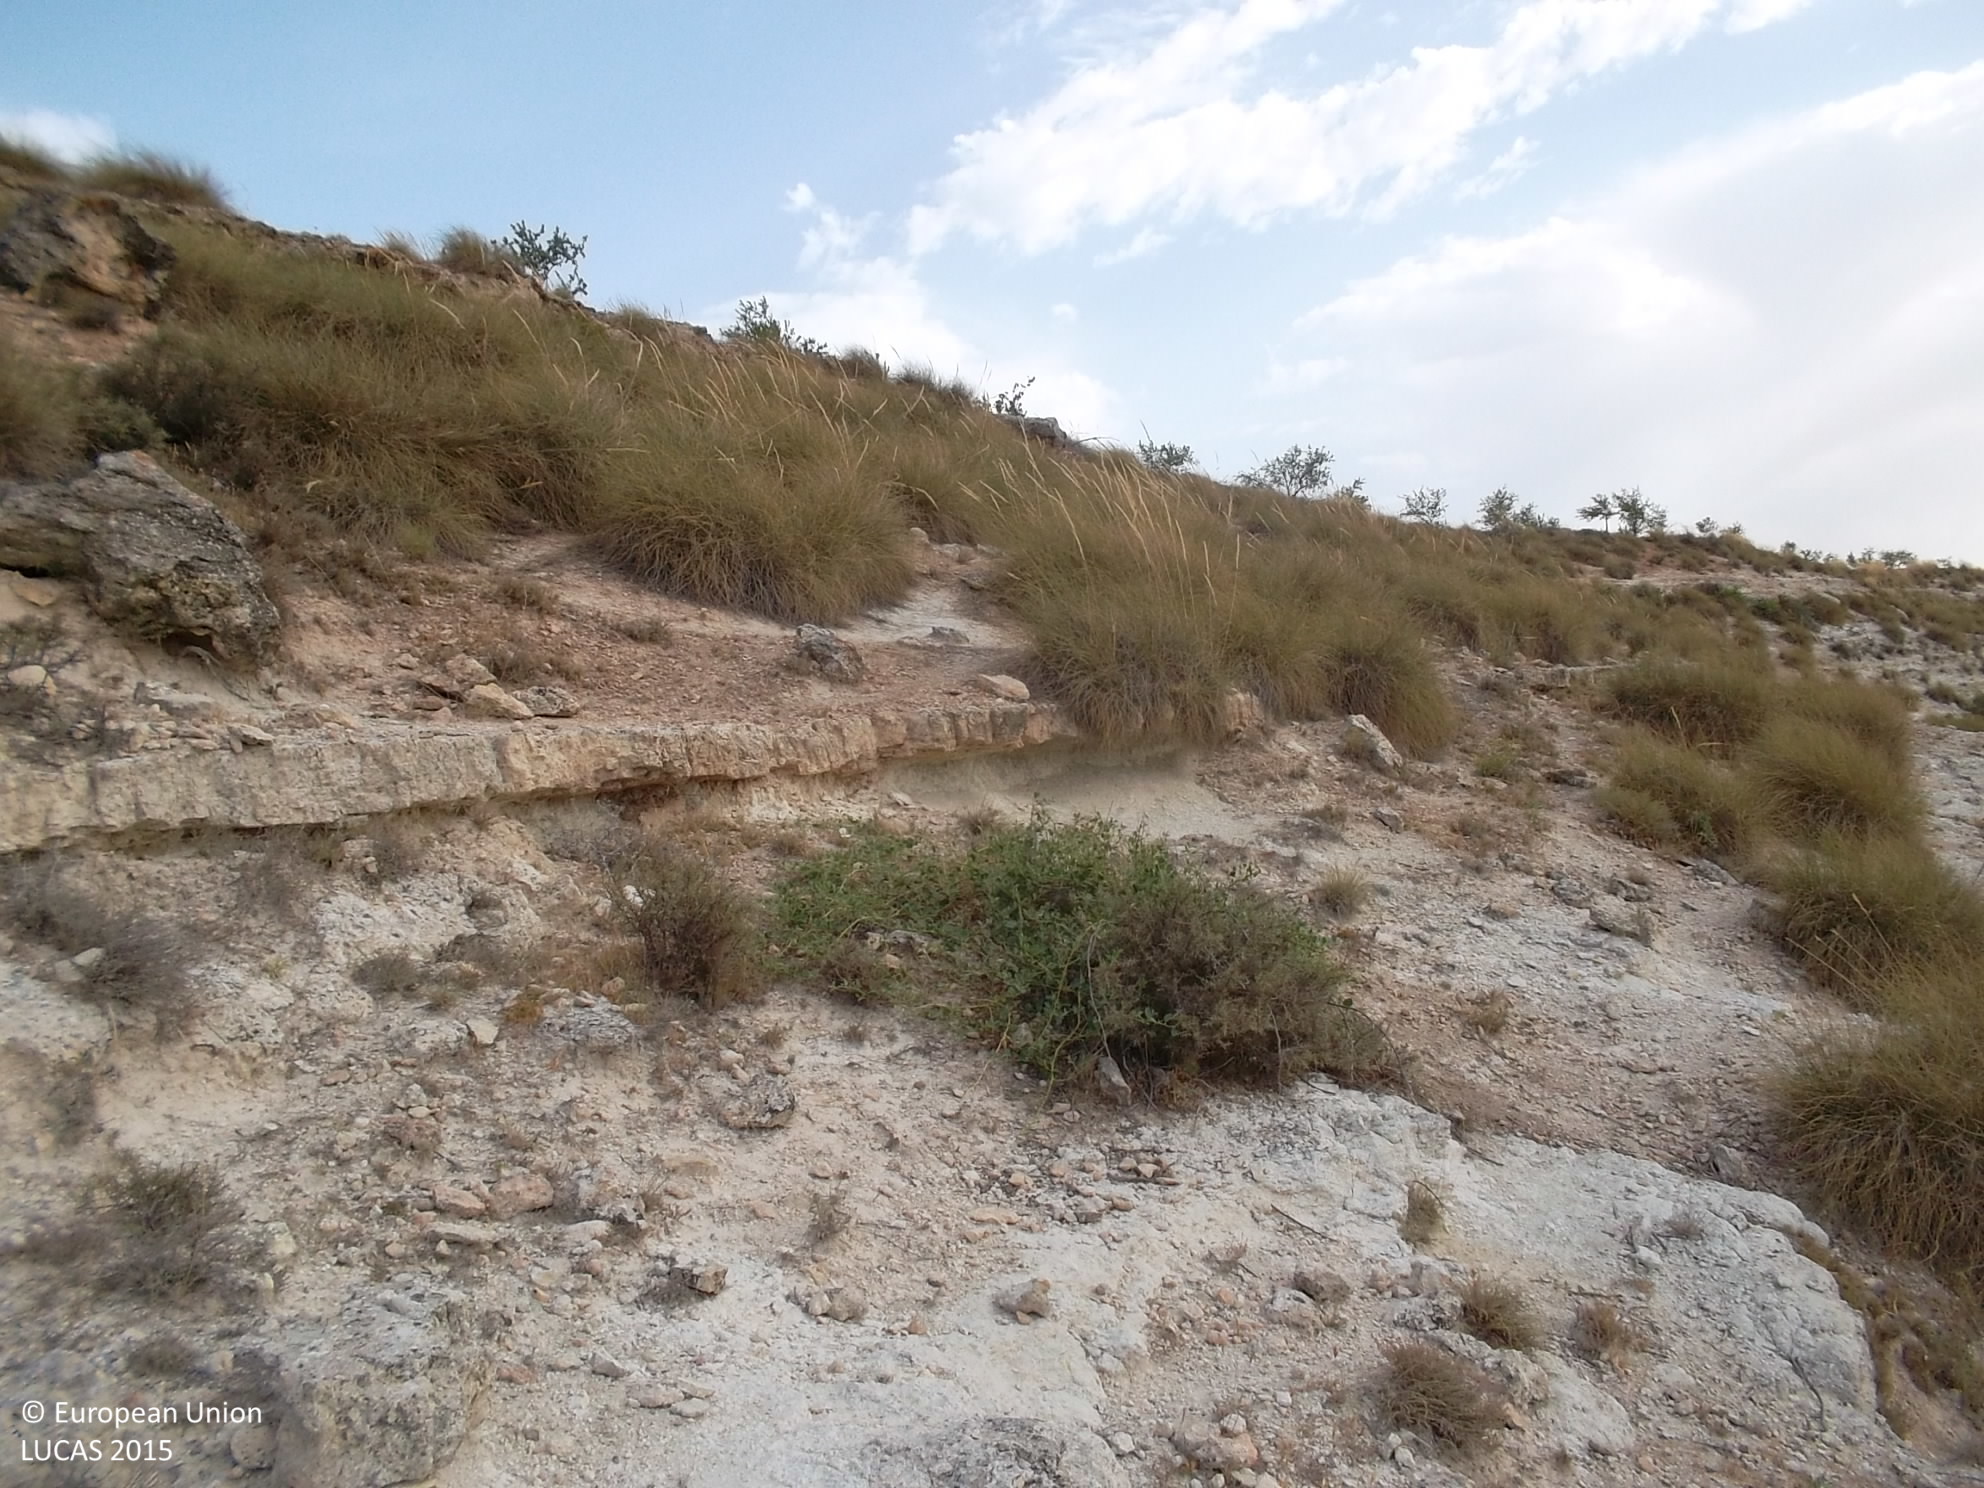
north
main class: Grassland
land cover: Grassland without tree/shrub cover
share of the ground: > 75 %
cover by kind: herbaceous plants 100 %
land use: Agriculture (excluding fallow land and kitchen gardens)
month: July
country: ES
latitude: 37.5165
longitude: -2.8293
